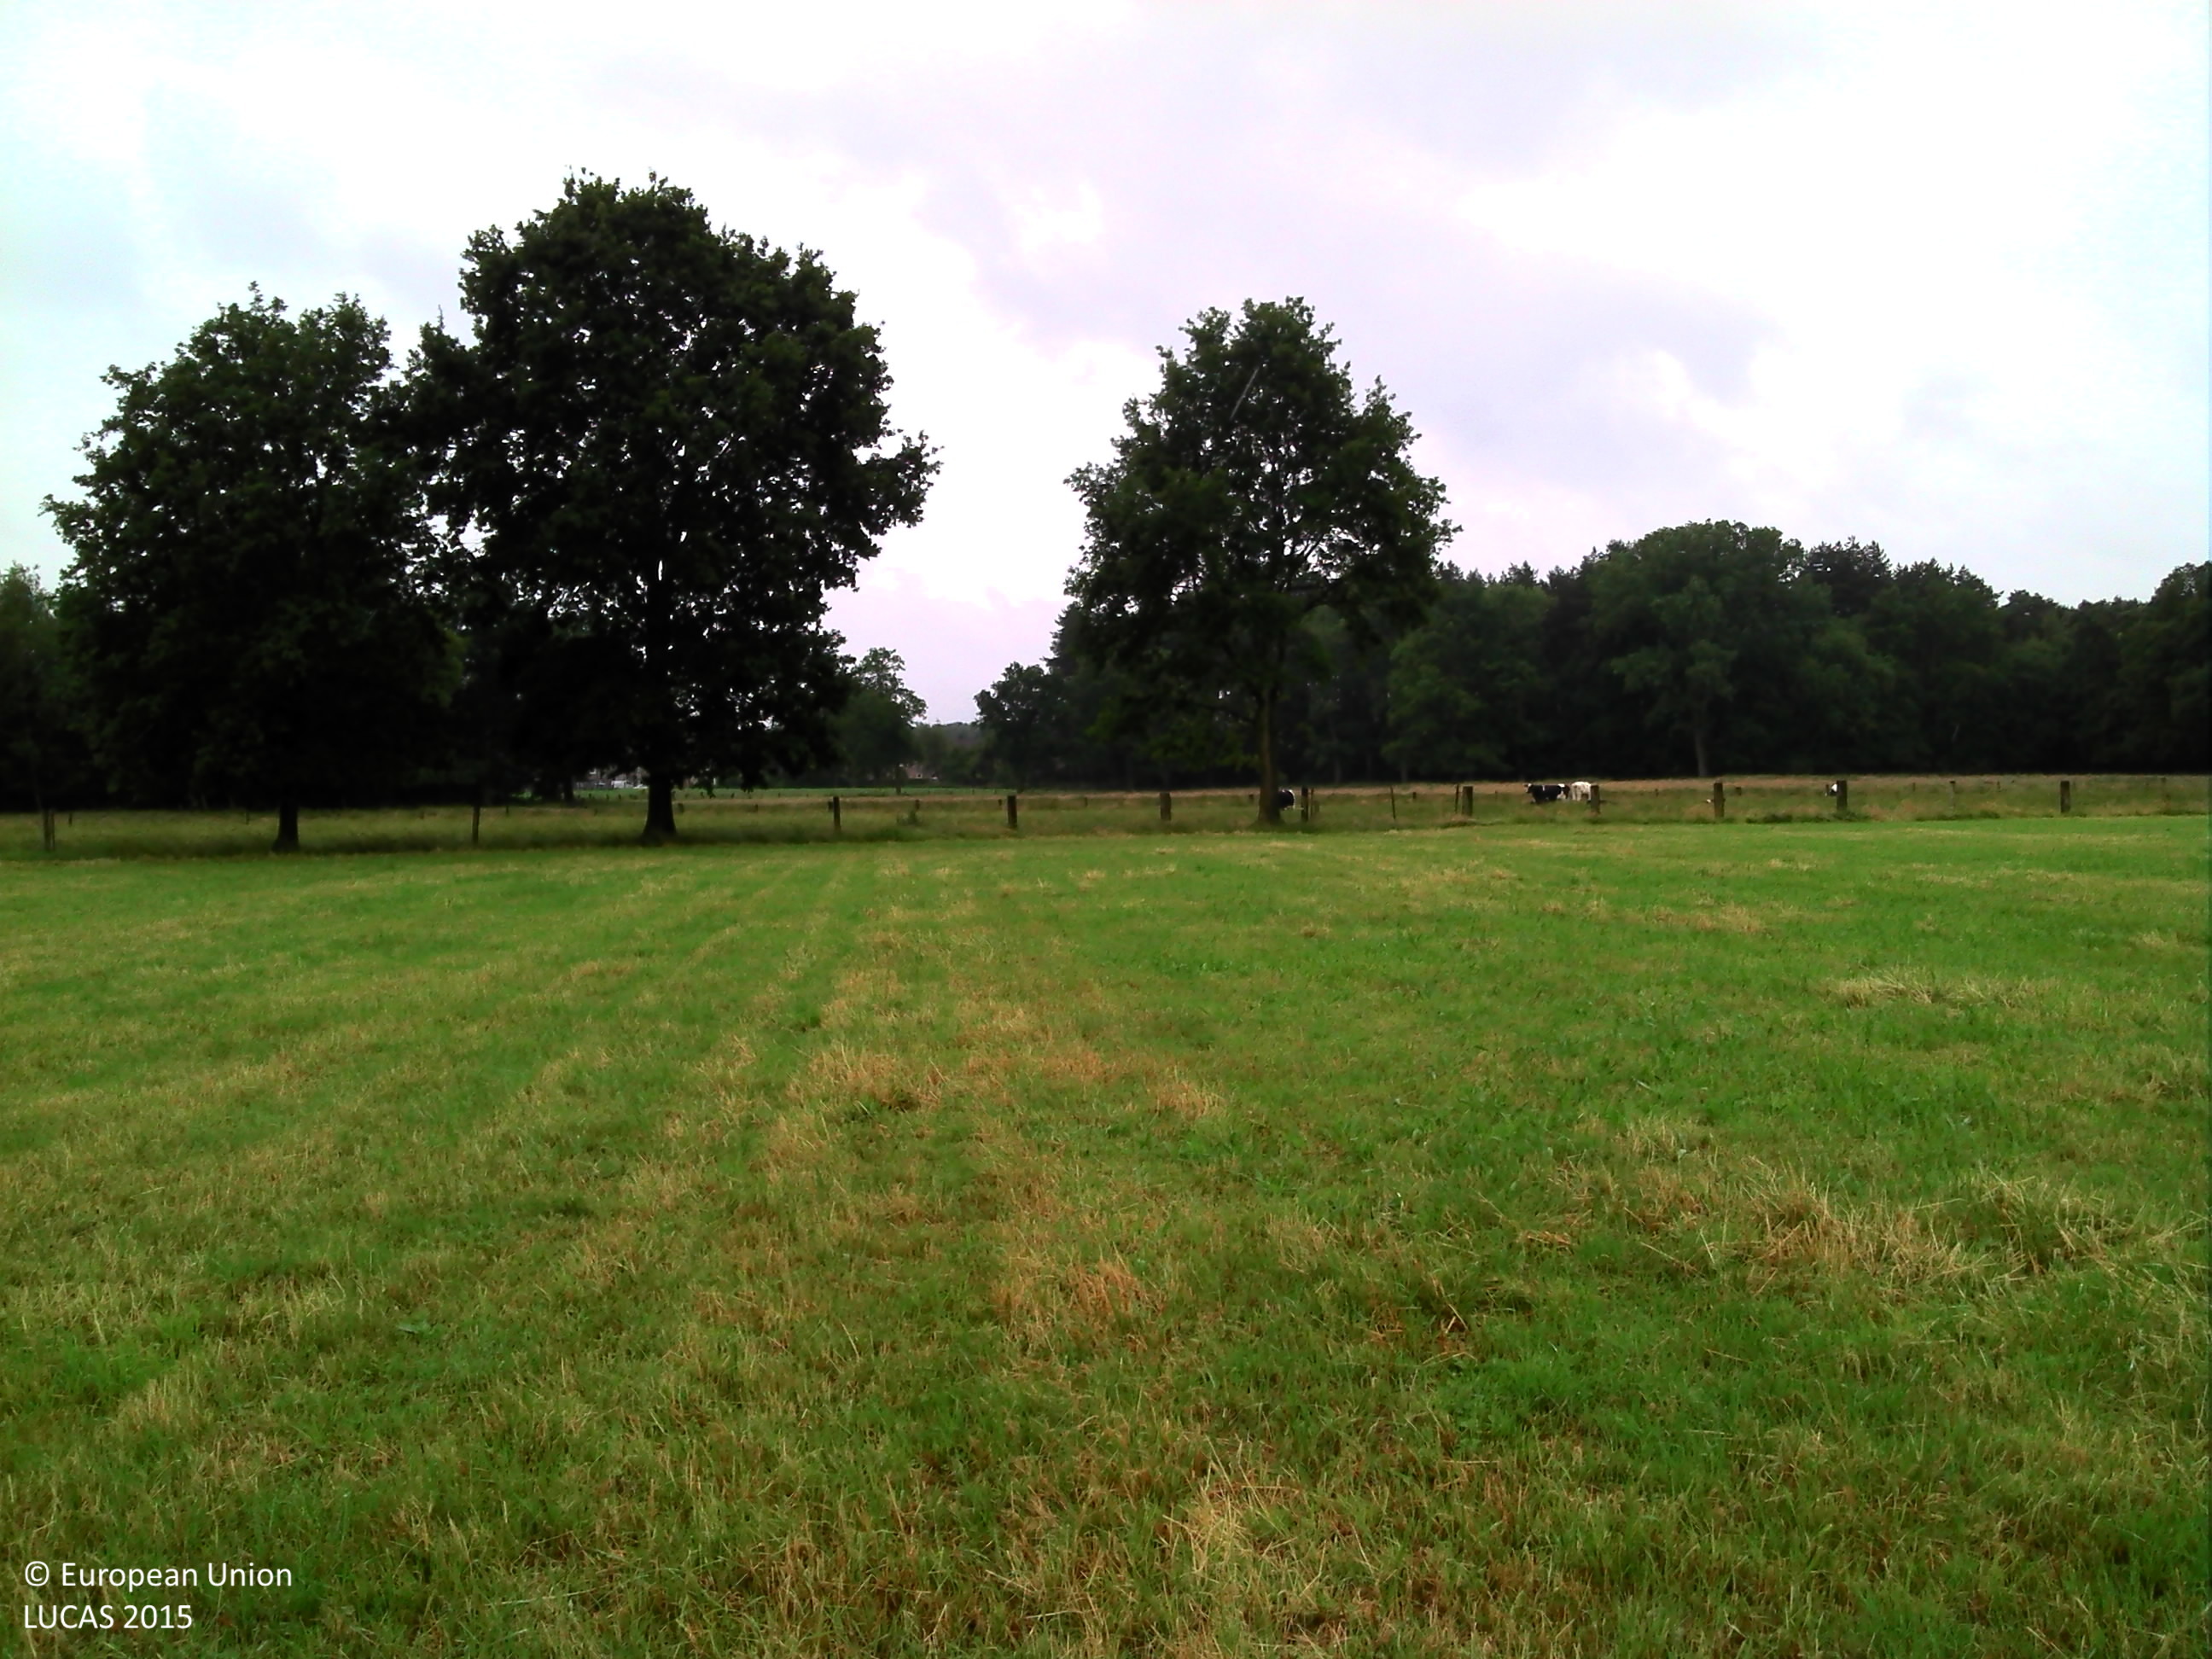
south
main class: Grassland
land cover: Grassland without tree/shrub cover
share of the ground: > 75 %
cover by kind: herbaceous plants 100 %
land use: Agriculture (excluding fallow land and kitchen gardens)
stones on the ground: < 10 %
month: June
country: BE
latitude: 51.0937
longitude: 5.2429
